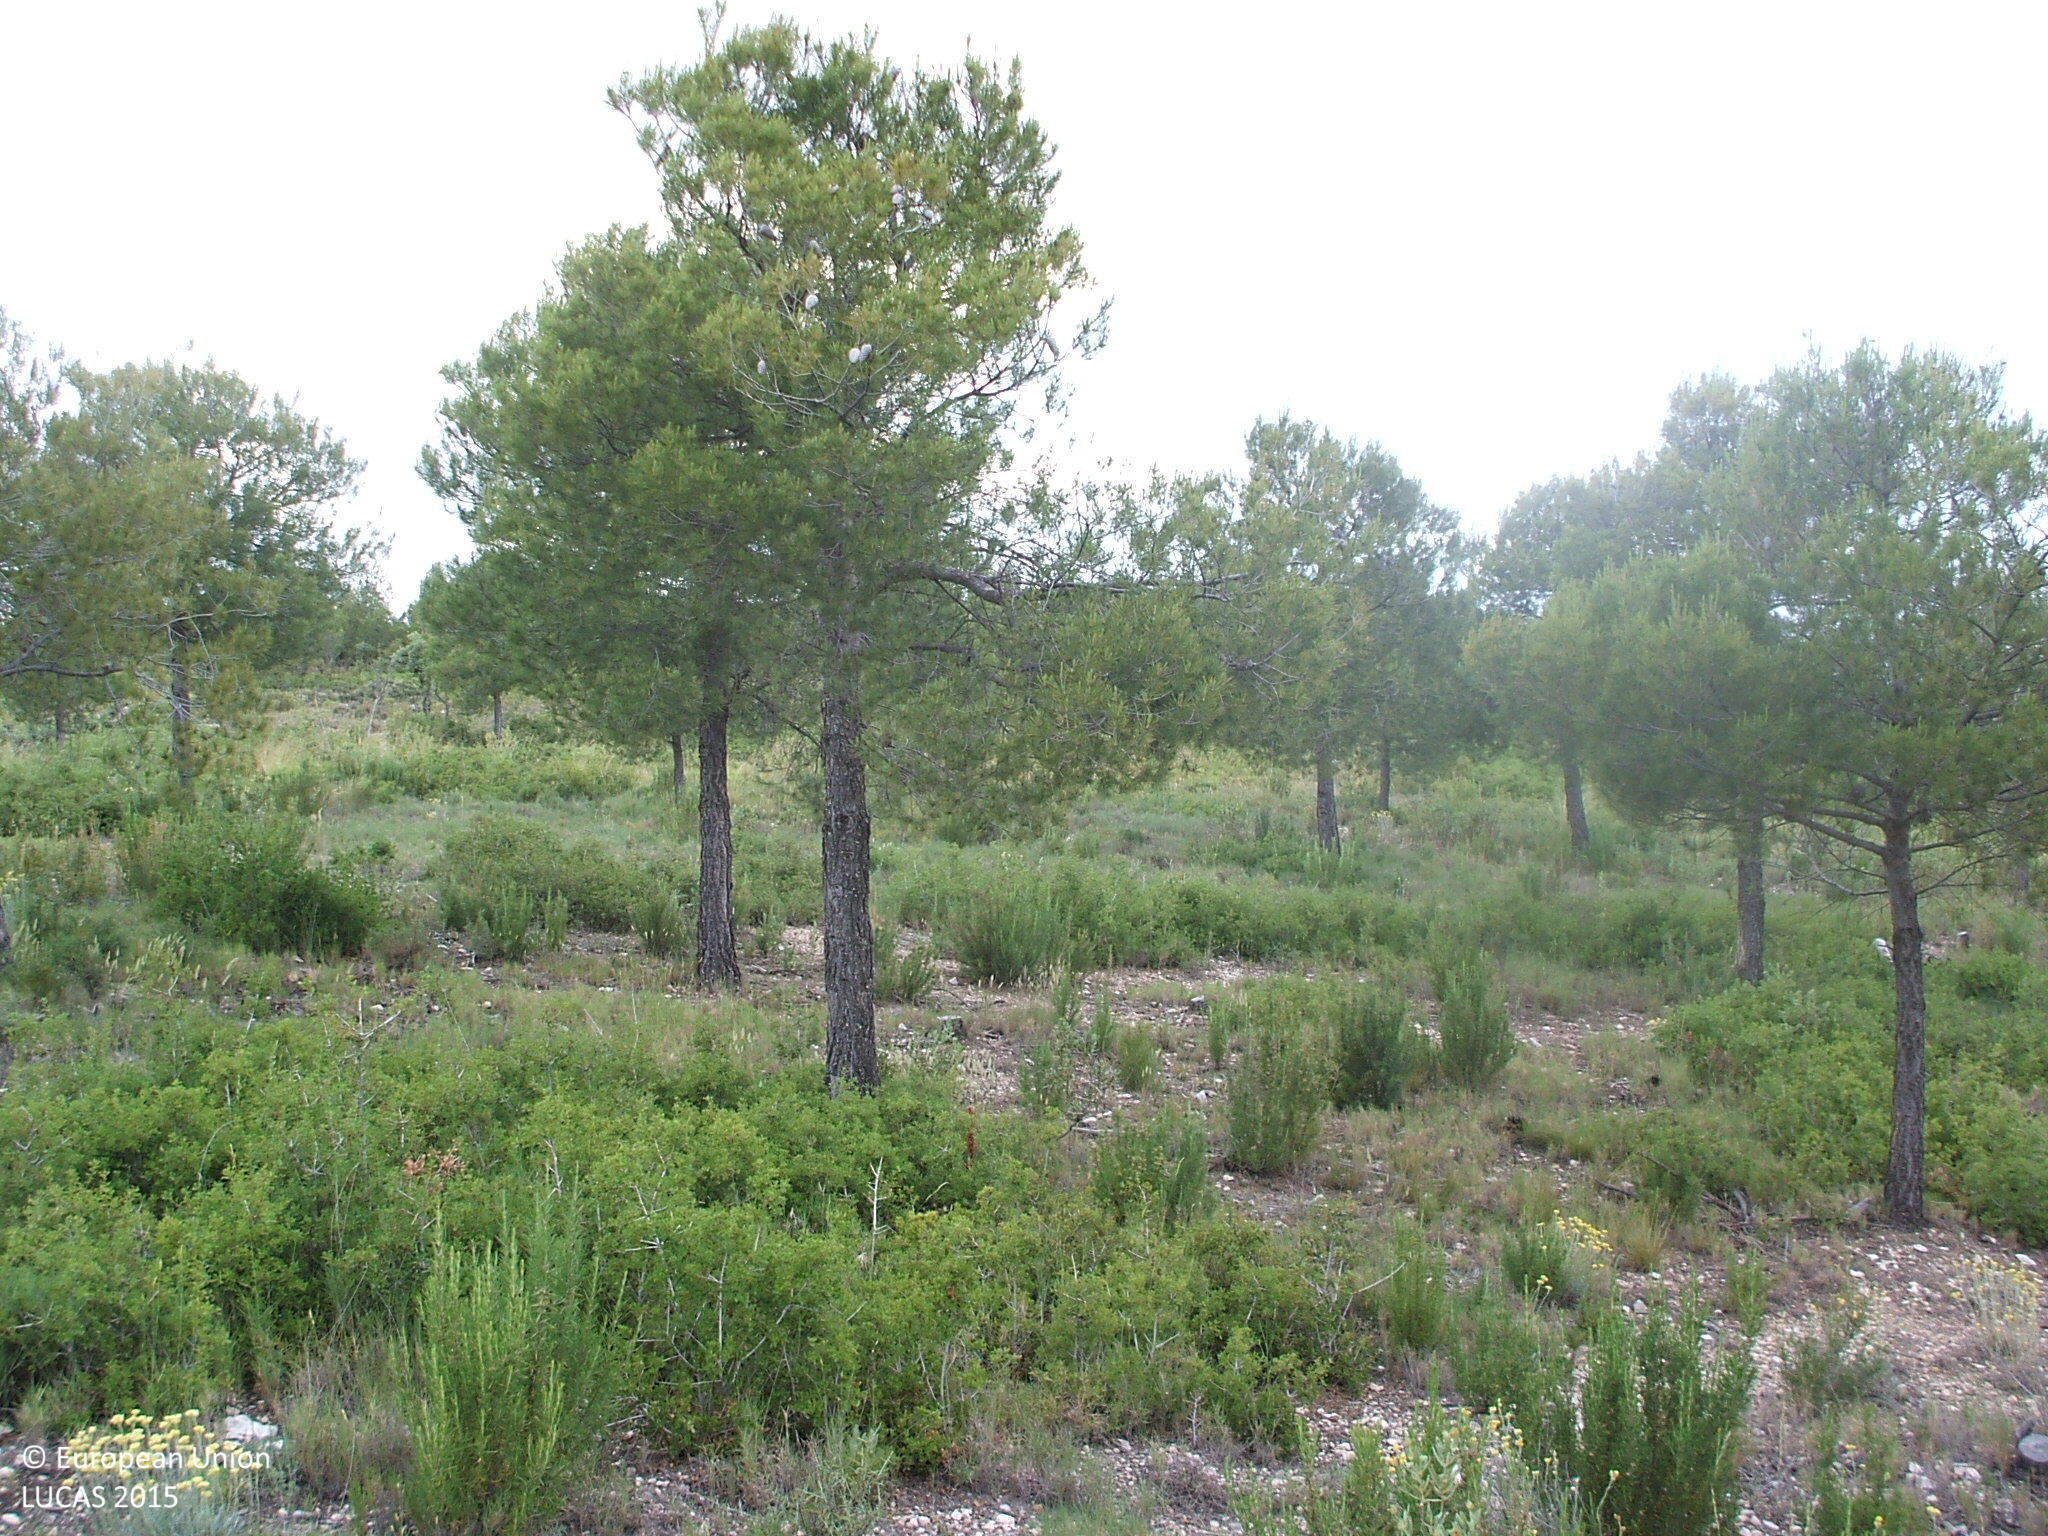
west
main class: Woodland
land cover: Pine dominated coniferous woodland
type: coniferous forest of the mediterranean region
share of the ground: > 75 %
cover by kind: coniferous forest trees 100 %
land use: Semi-natural and natural areas not in use
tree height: > 5 m
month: June
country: ES
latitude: 40.8865
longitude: -0.1573
